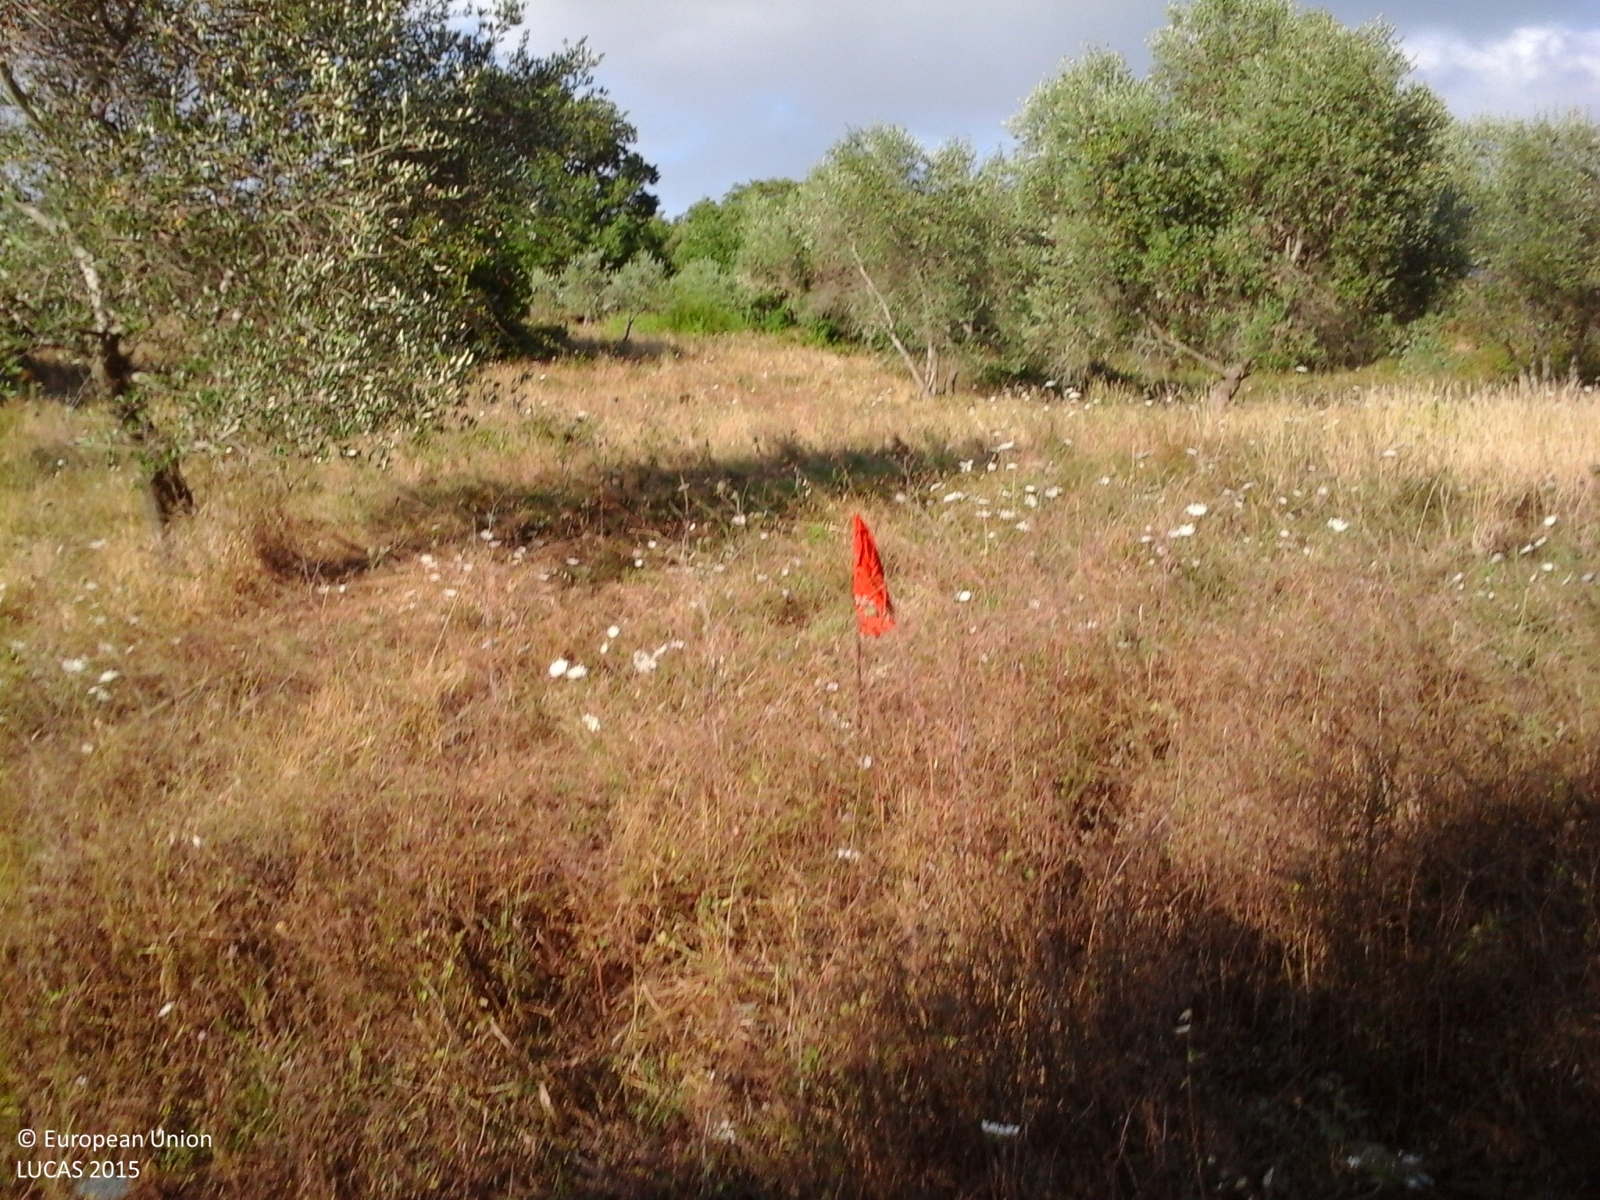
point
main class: Cropland
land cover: Olive groves
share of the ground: > 75 %
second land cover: Temporary grasslands
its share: > 75 %
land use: Agriculture (excluding fallow land and kitchen gardens)
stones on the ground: < 10 %
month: July
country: IT
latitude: 43.0405
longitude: 11.4807
